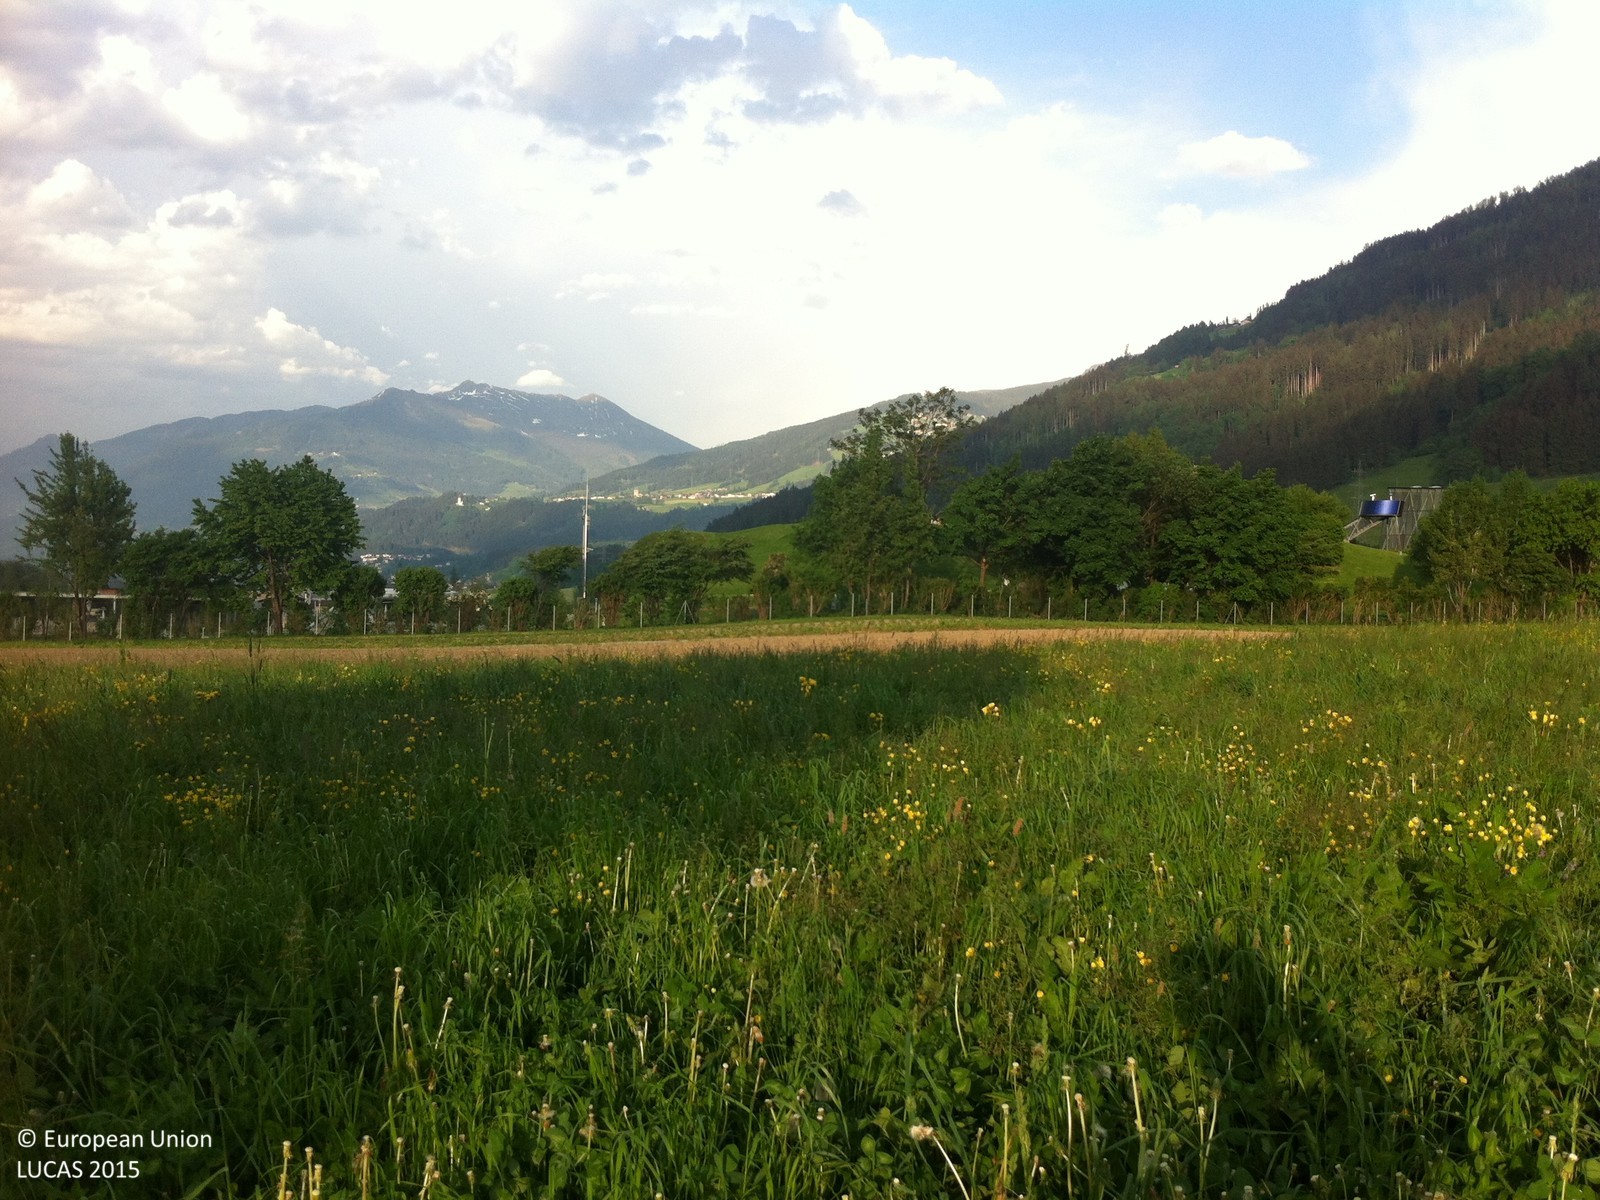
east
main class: Grassland
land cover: Grassland without tree/shrub cover
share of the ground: > 75 %
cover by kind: herbaceous plants 100 %
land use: Agriculture (excluding fallow land and kitchen gardens)
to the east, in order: Grassland without tree/shrub cover; Common wheat; Paved roads, cycling and walking lanes; Strawberries; Fences; Broadleaved woodland; Artificial constructions in urban areas
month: May
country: AT
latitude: 47.2938
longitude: 11.5987
